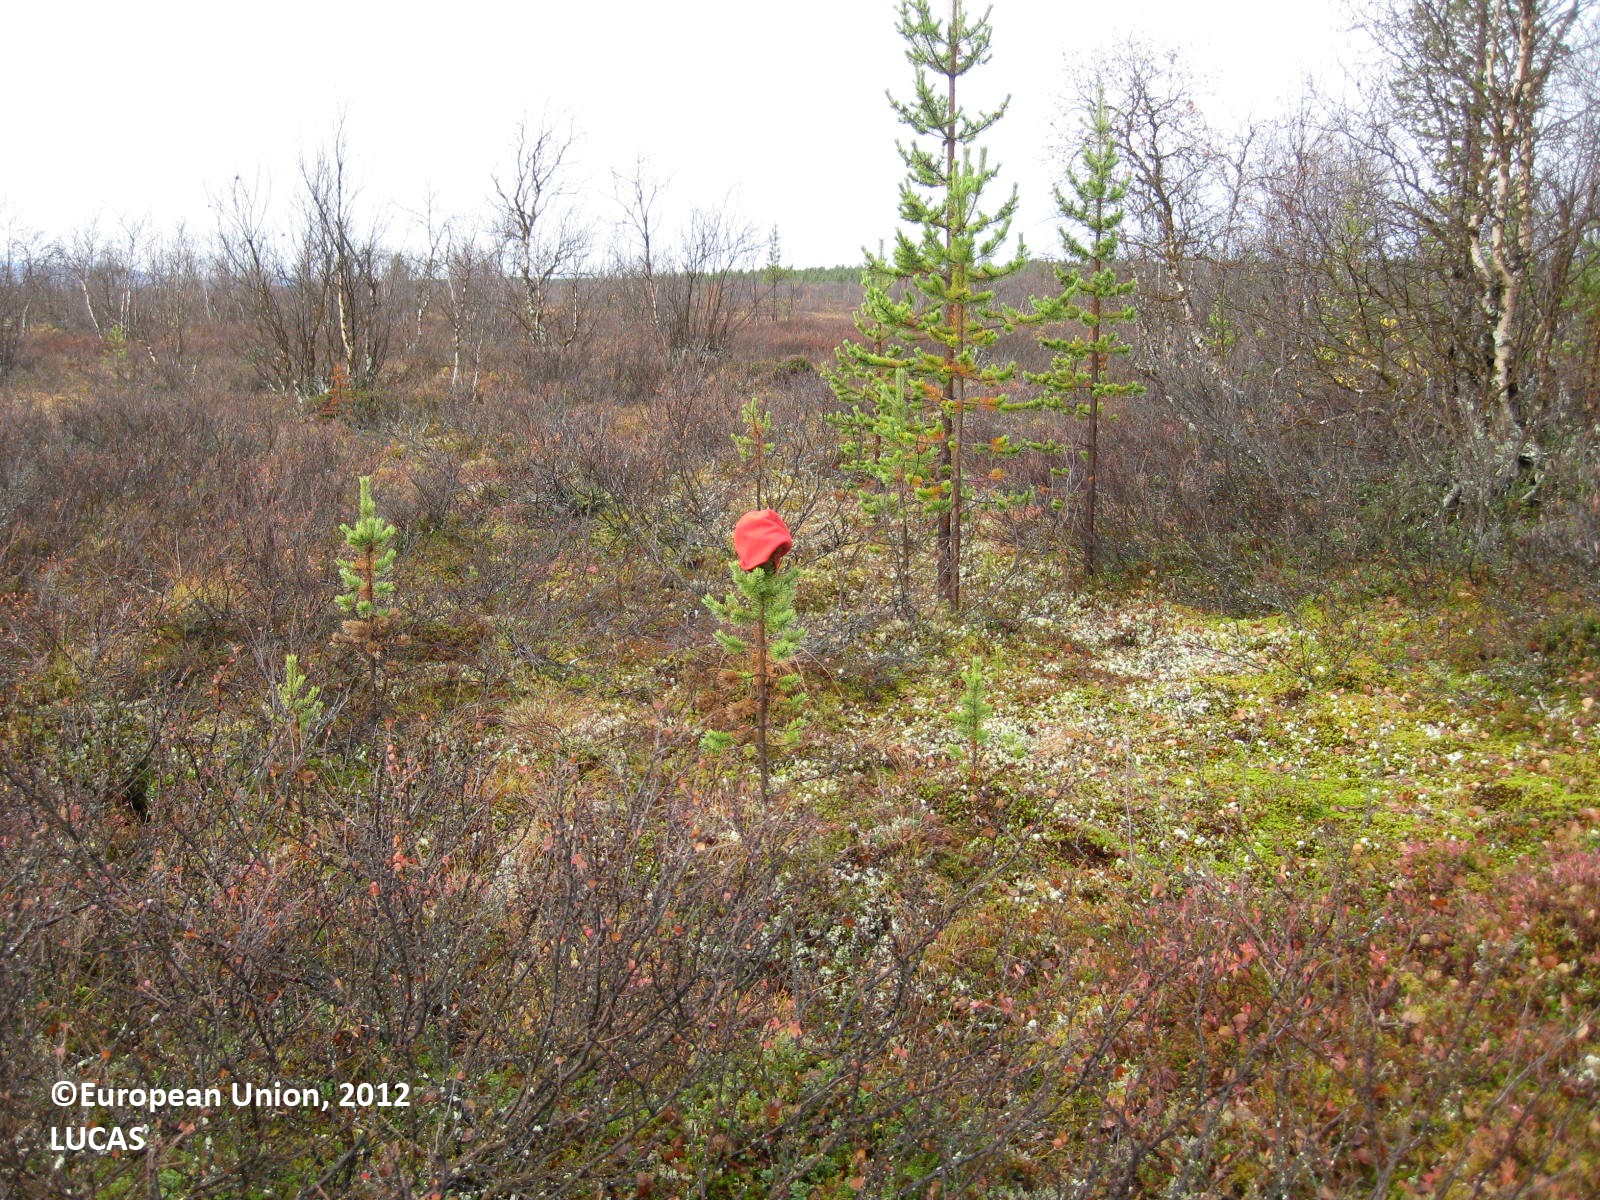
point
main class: Woodland
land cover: Pine dominated mixed woodland
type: boreal forest
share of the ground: 50 - 75 %
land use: Semi-natural and natural areas not in use
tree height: > 5 m
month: September
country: FI
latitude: 68.3999
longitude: 24.3028
